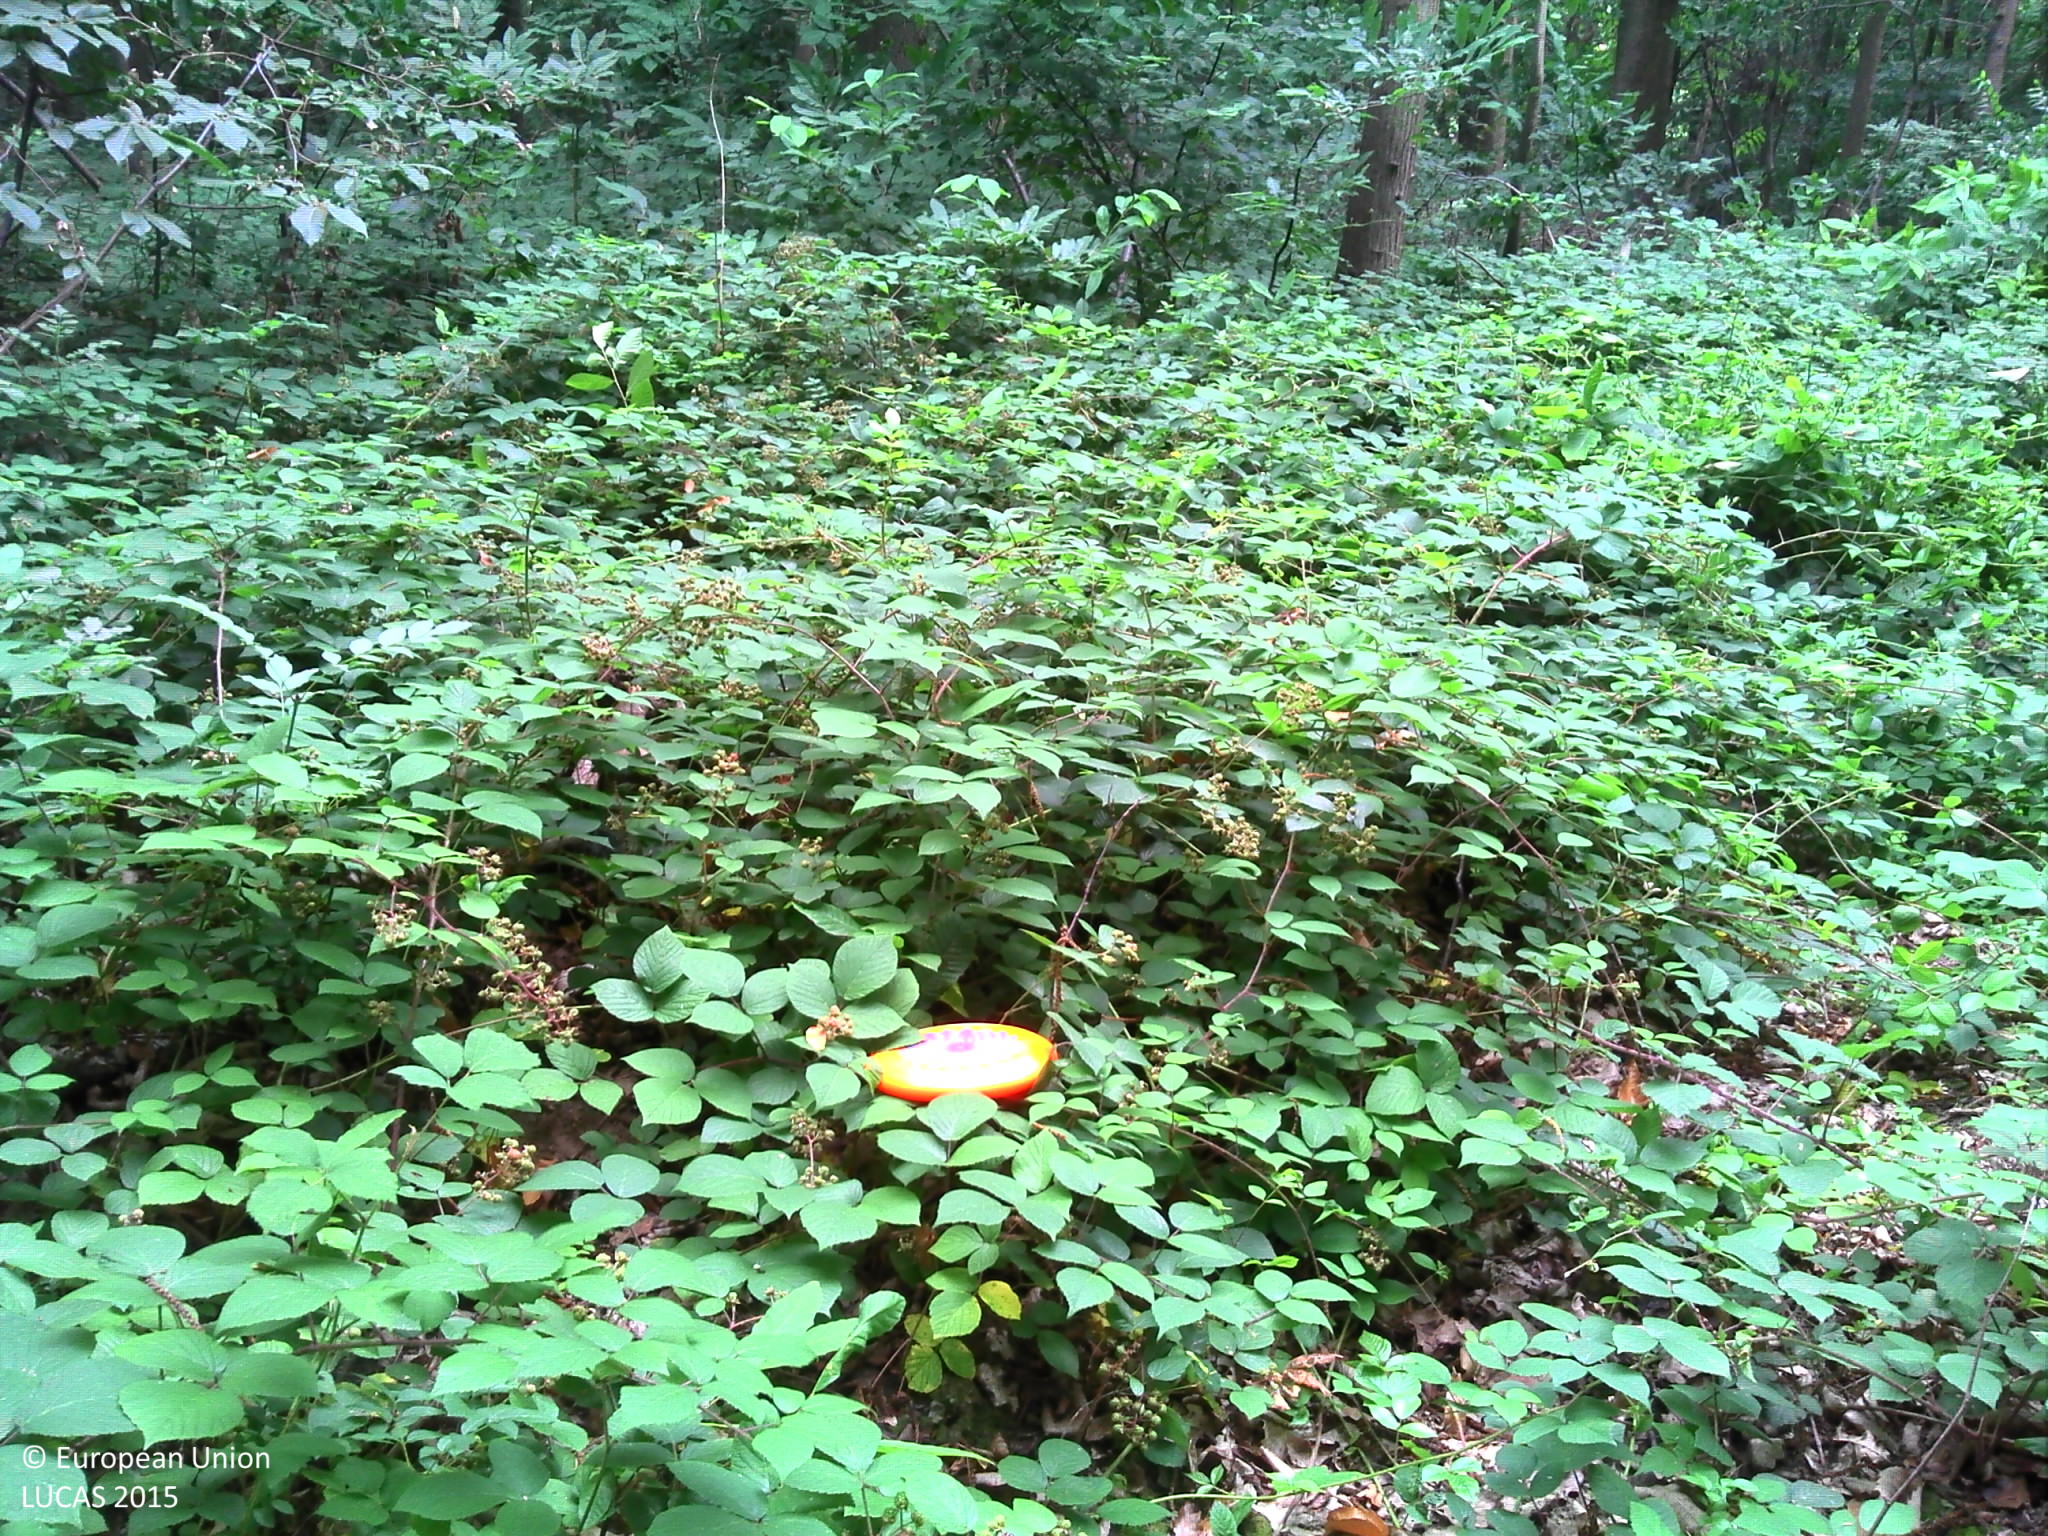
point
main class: Woodland
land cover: Broadleaved woodland
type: mesophytic deciduous forest
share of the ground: > 75 %
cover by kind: broadleaved forest trees 40 %, shrubs 20 %, lichens and mosses 10 %, consolidated bare surface 5 %
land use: Forestry
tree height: > 5 m
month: July
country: FR
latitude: 49.0929
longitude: 2.3048
